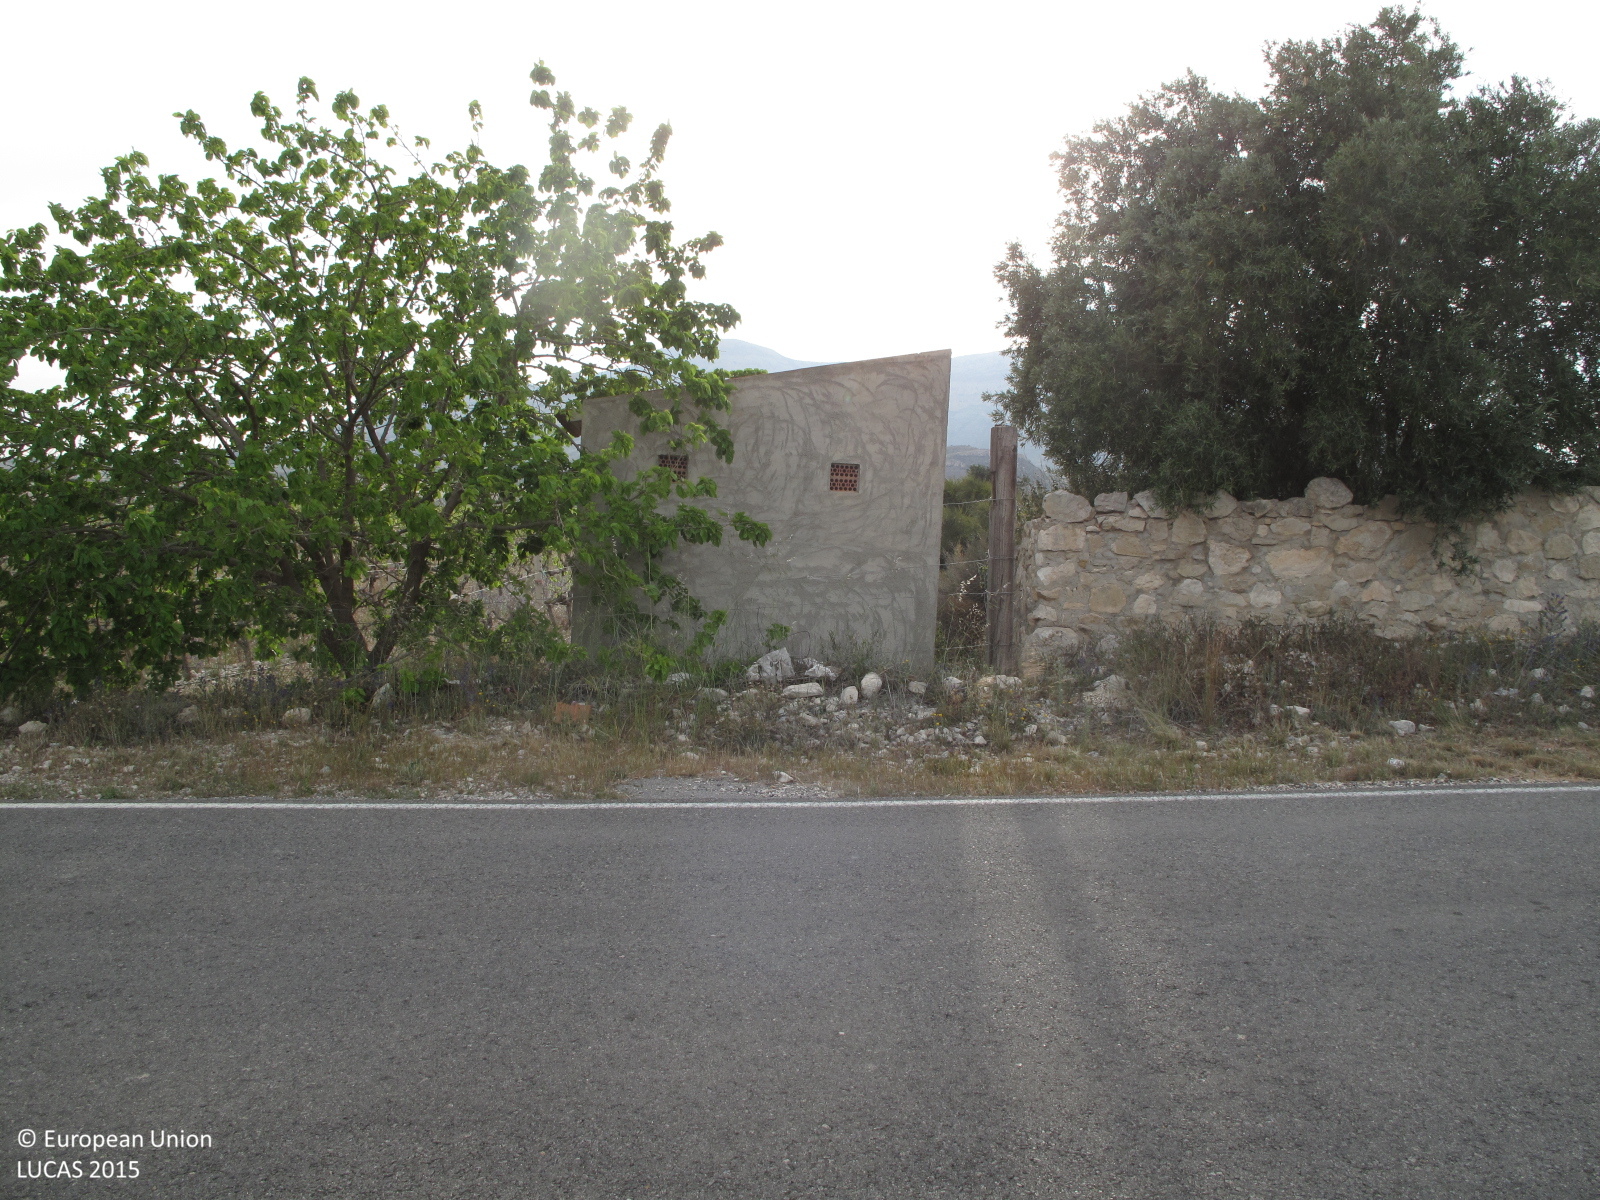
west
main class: Grassland
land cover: Spontaneously vegetated surfaces
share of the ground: > 75 %
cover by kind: herbaceous plants 80 %, unconsolidated bare surface 20 %
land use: Abandoned areas
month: April
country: ES
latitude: 38.4625
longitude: -0.6571
